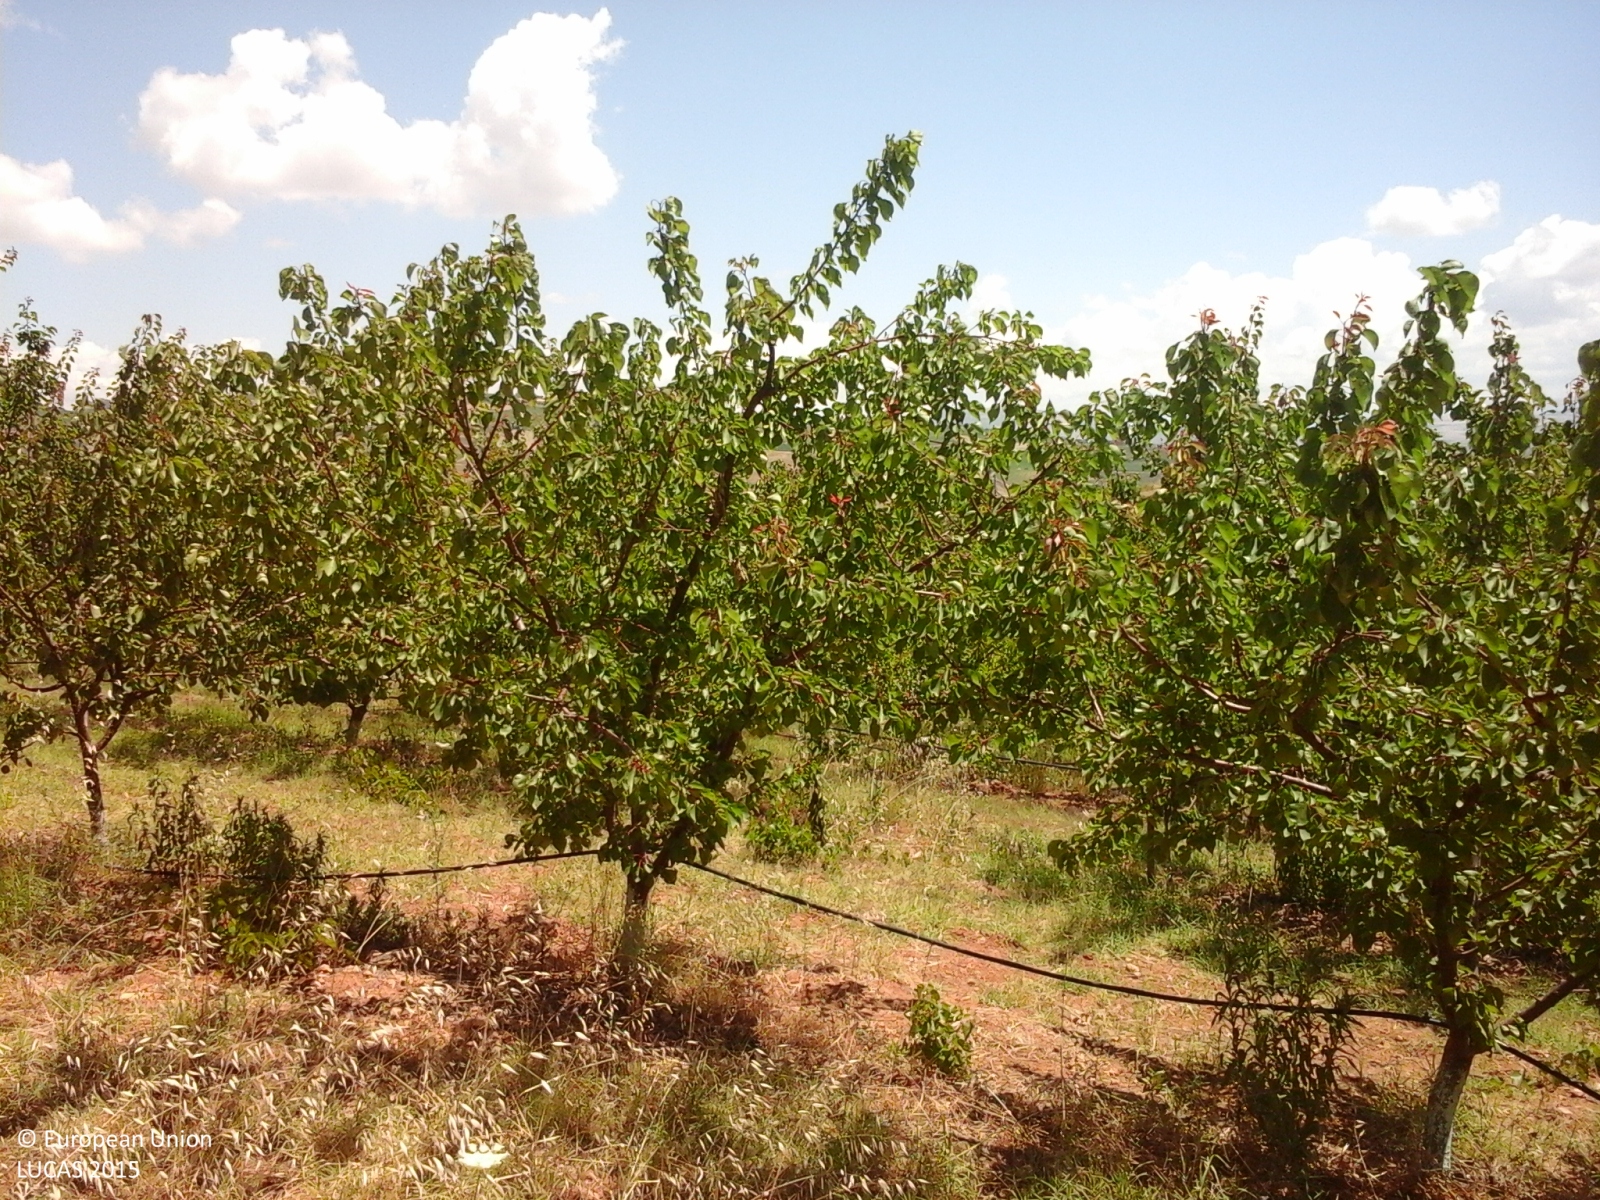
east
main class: Cropland
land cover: Other fruit trees and berries
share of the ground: 25 - 50 %
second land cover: Spontaneously vegetated surfaces
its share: 50 - 75 %
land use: Agriculture (excluding fallow land and kitchen gardens)
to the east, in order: Other fruit trees and berries; Spontaneously vegetated surfaces; Grass margins; Tracks; Grass margins; Grassland with sparse tree/shrub cover; Paved roads, cycling and walking lanes; Grass margins; Spontaneously vegetated surfaces
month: June
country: IT
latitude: 37.7385
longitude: 12.9398
